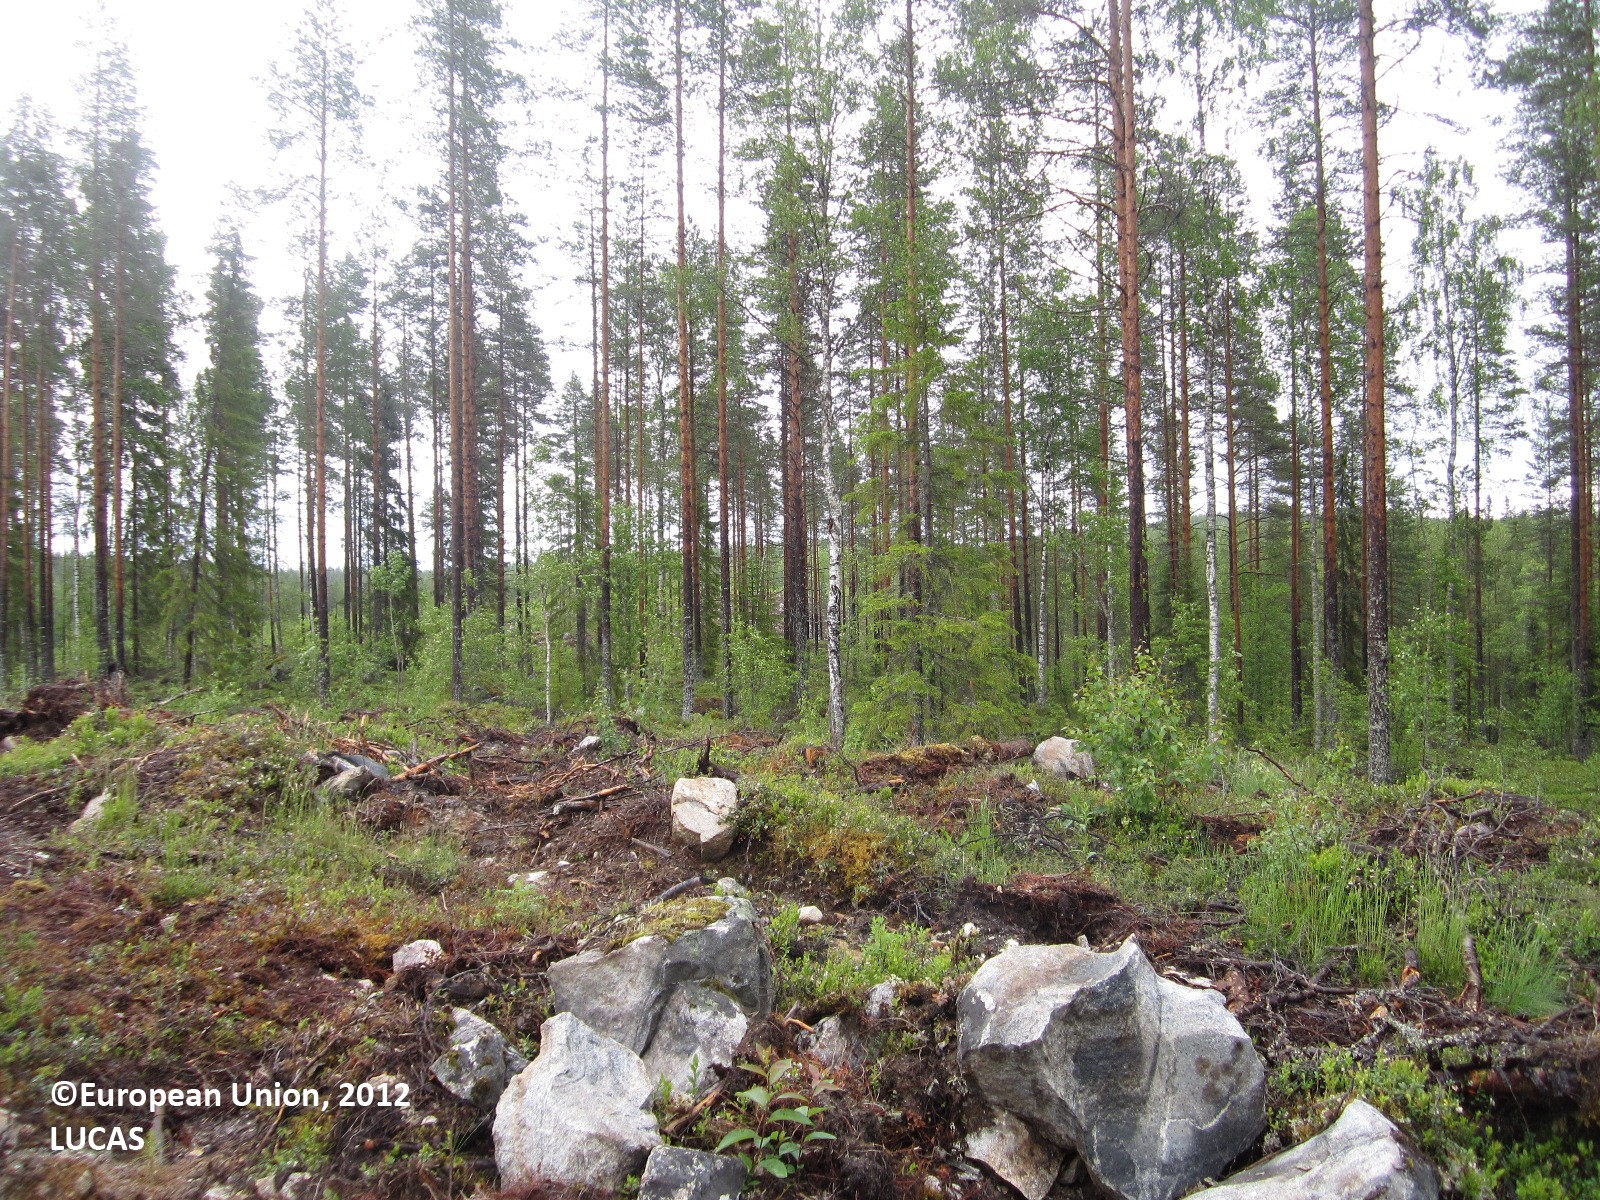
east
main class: Shrubland
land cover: Shrubland with sparse tree cover
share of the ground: 10 - 25 %
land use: Forestry
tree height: < 5 m
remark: Clear cut
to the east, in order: Shrubland with sparse tree cover; Tracks; Pine dominated coniferous woodland; Rock outcrops; Pine dominated coniferous woodland; Shrubland without tree cover; Pine dominated mixed woodland; Rocks and stones; Lichens and moss; Pine dominated mixed woodland
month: June
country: FI
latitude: 64.2809
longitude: 29.4425
